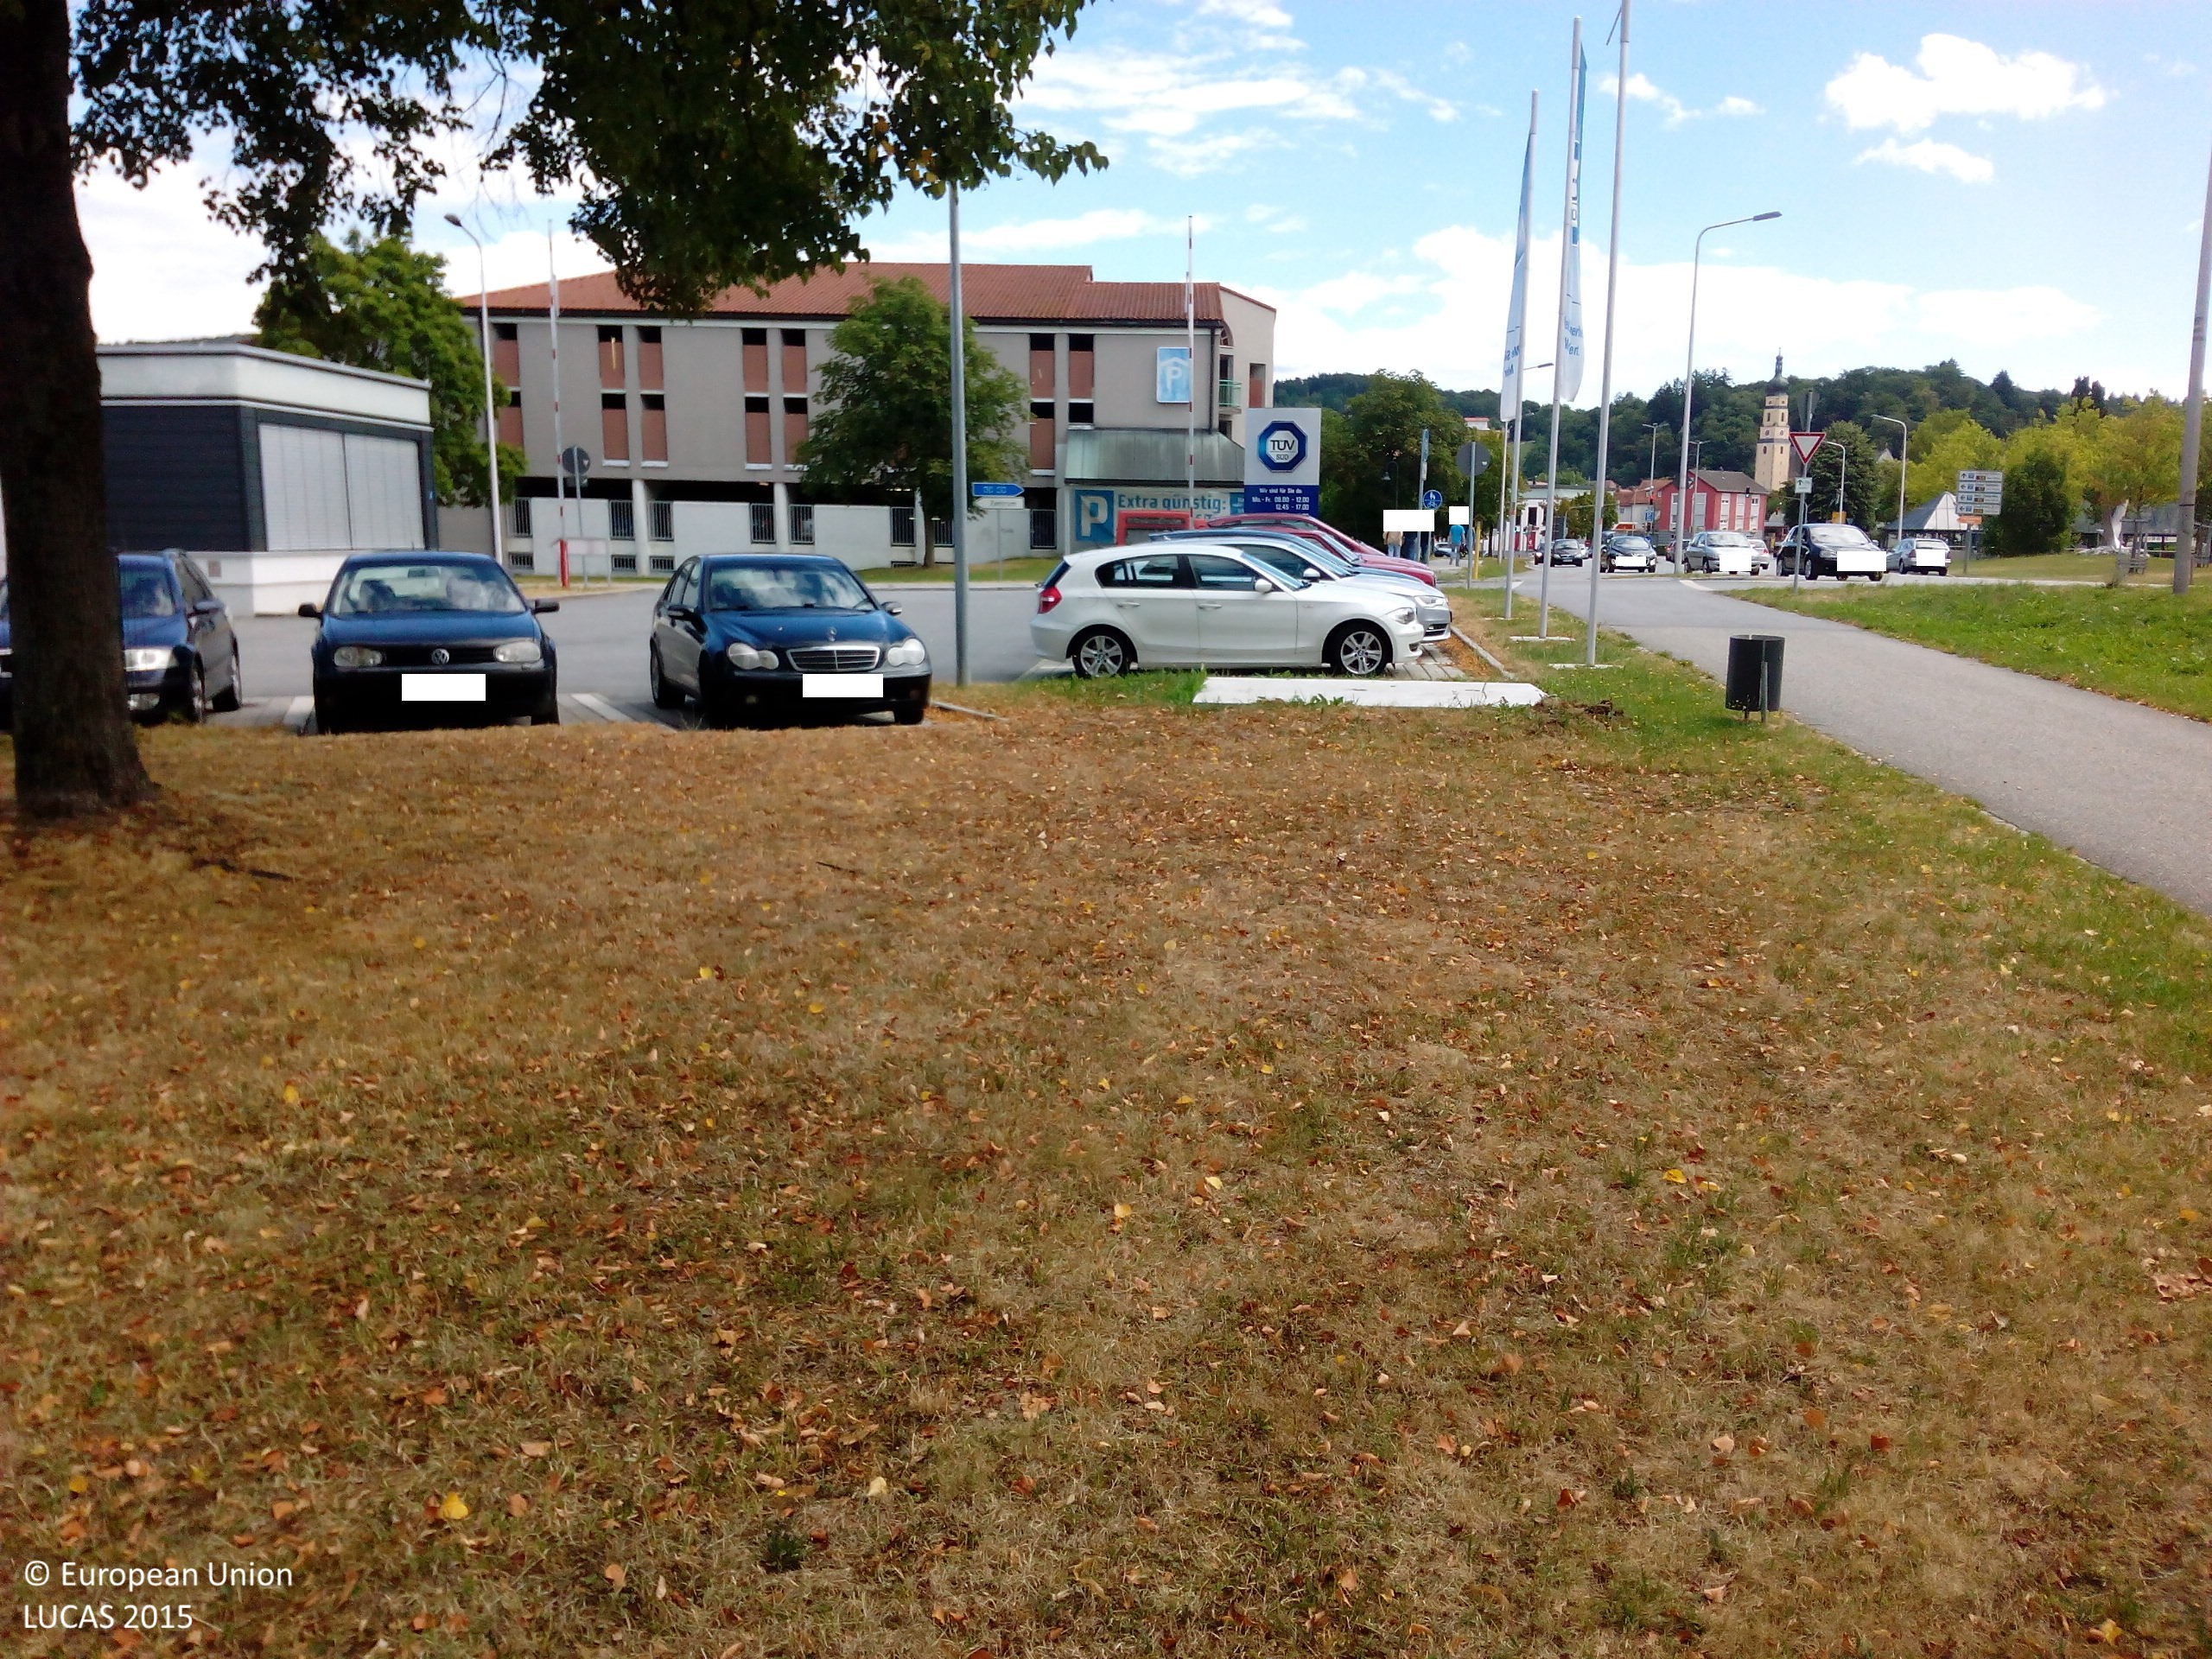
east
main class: Grassland
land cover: Grassland with sparse tree/shrub cover
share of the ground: > 75 %
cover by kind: herbaceous plants 95 %, broadleaved forest trees 5 %
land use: Community services
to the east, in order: Grassland with sparse tree/shrub cover; Artificial constructions in urban areas
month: July
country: DE
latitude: 48.8321
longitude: 12.9557
